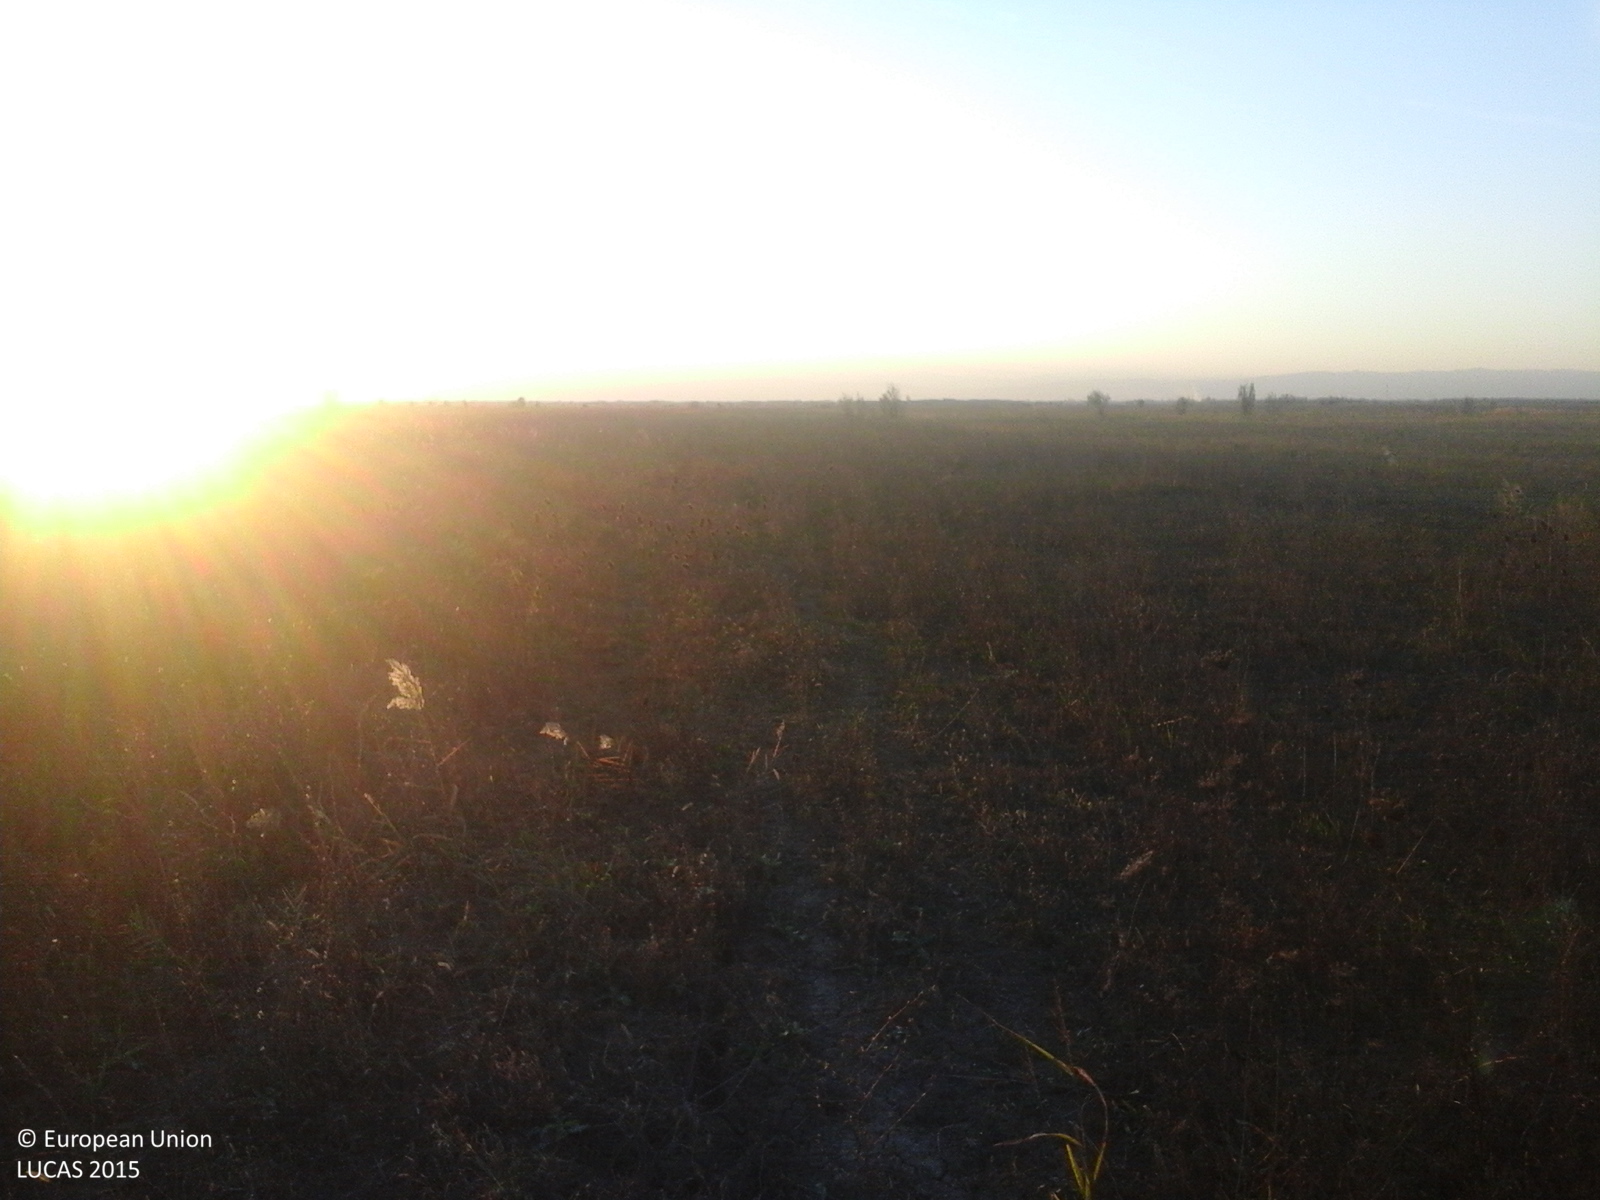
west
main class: Grassland
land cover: Spontaneously vegetated surfaces
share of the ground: > 75 %
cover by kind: herbaceous plants 100 %
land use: Agriculture (excluding fallow land and kitchen gardens)
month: October
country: RO
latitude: 45.6058
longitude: 27.3174
